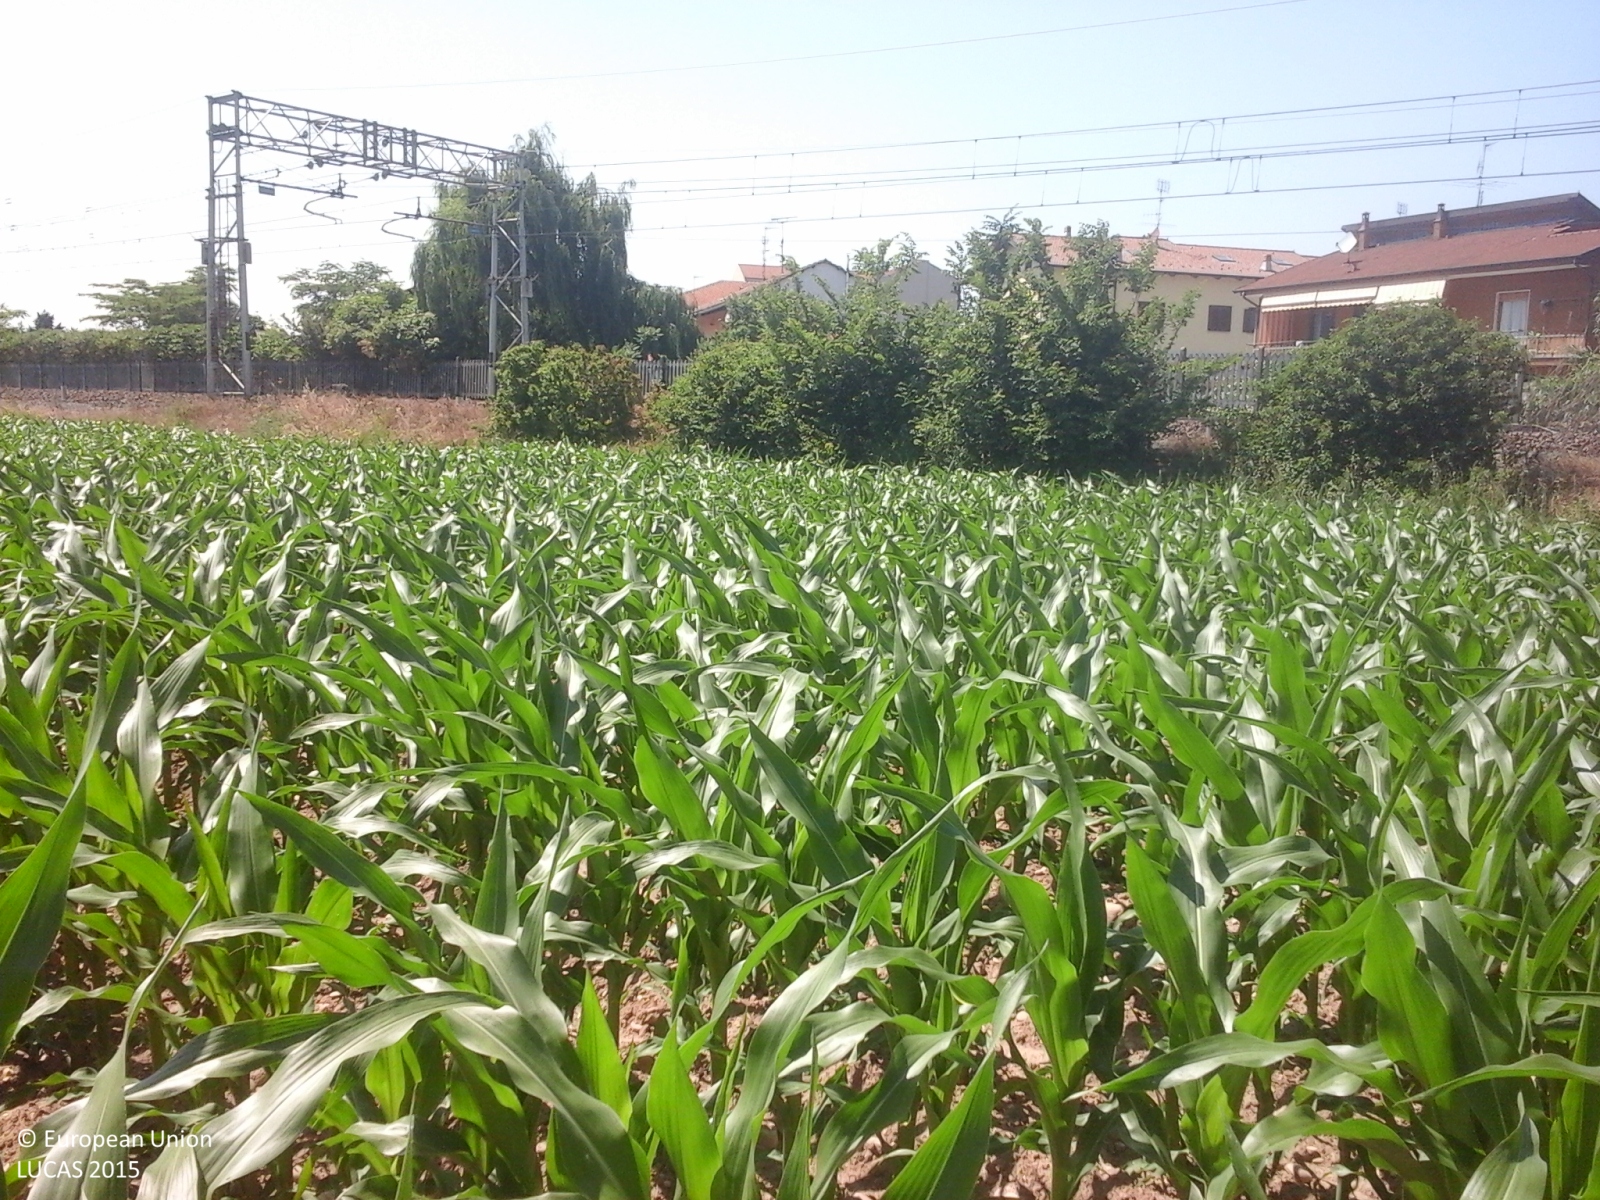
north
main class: Cropland
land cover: Maize
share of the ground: 50 - 75 %
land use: Agriculture (excluding fallow land and kitchen gardens)
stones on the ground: 10 - 25 %
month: May
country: IT
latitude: 45.2146
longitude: 7.9789
